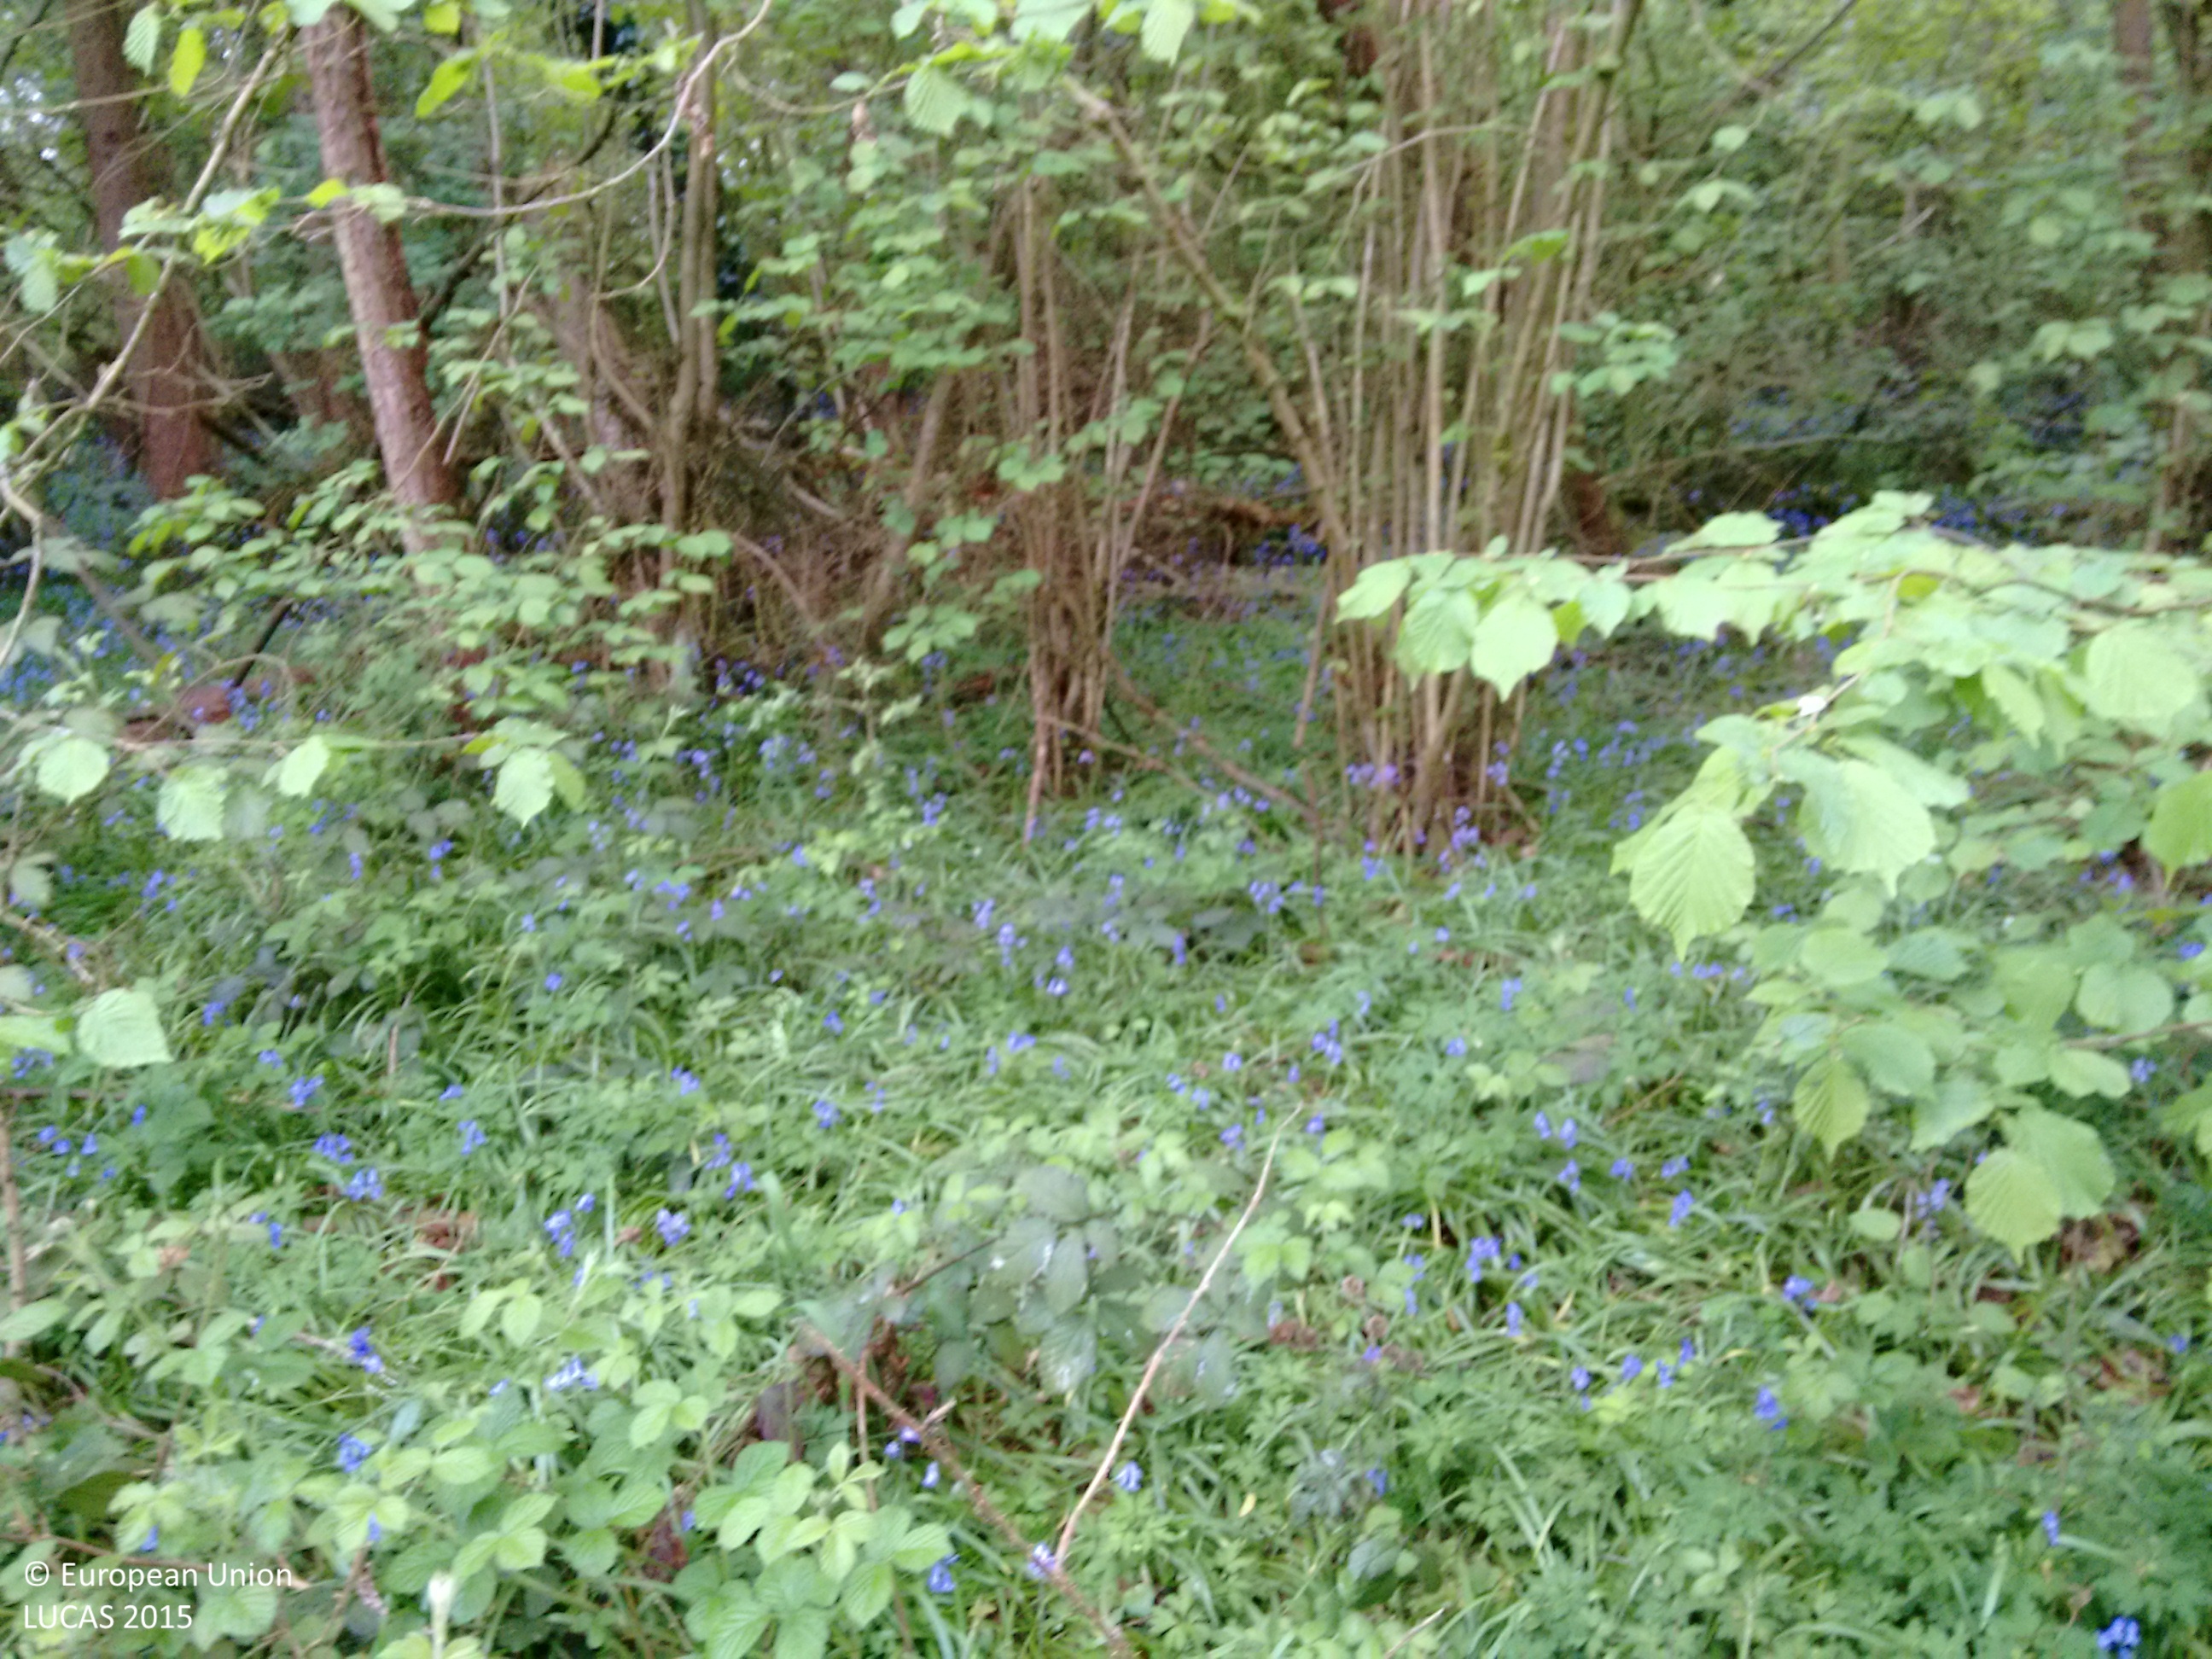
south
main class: Woodland
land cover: Broadleaved woodland
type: mesophytic deciduous forest
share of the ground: > 75 %
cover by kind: broadleaved forest trees 85 %, herbaceous plants 10 %, shrubs 5 %
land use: Semi-natural and natural areas not in use
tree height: > 5 m
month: May
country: GB
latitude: 52.2924
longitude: -2.1865
